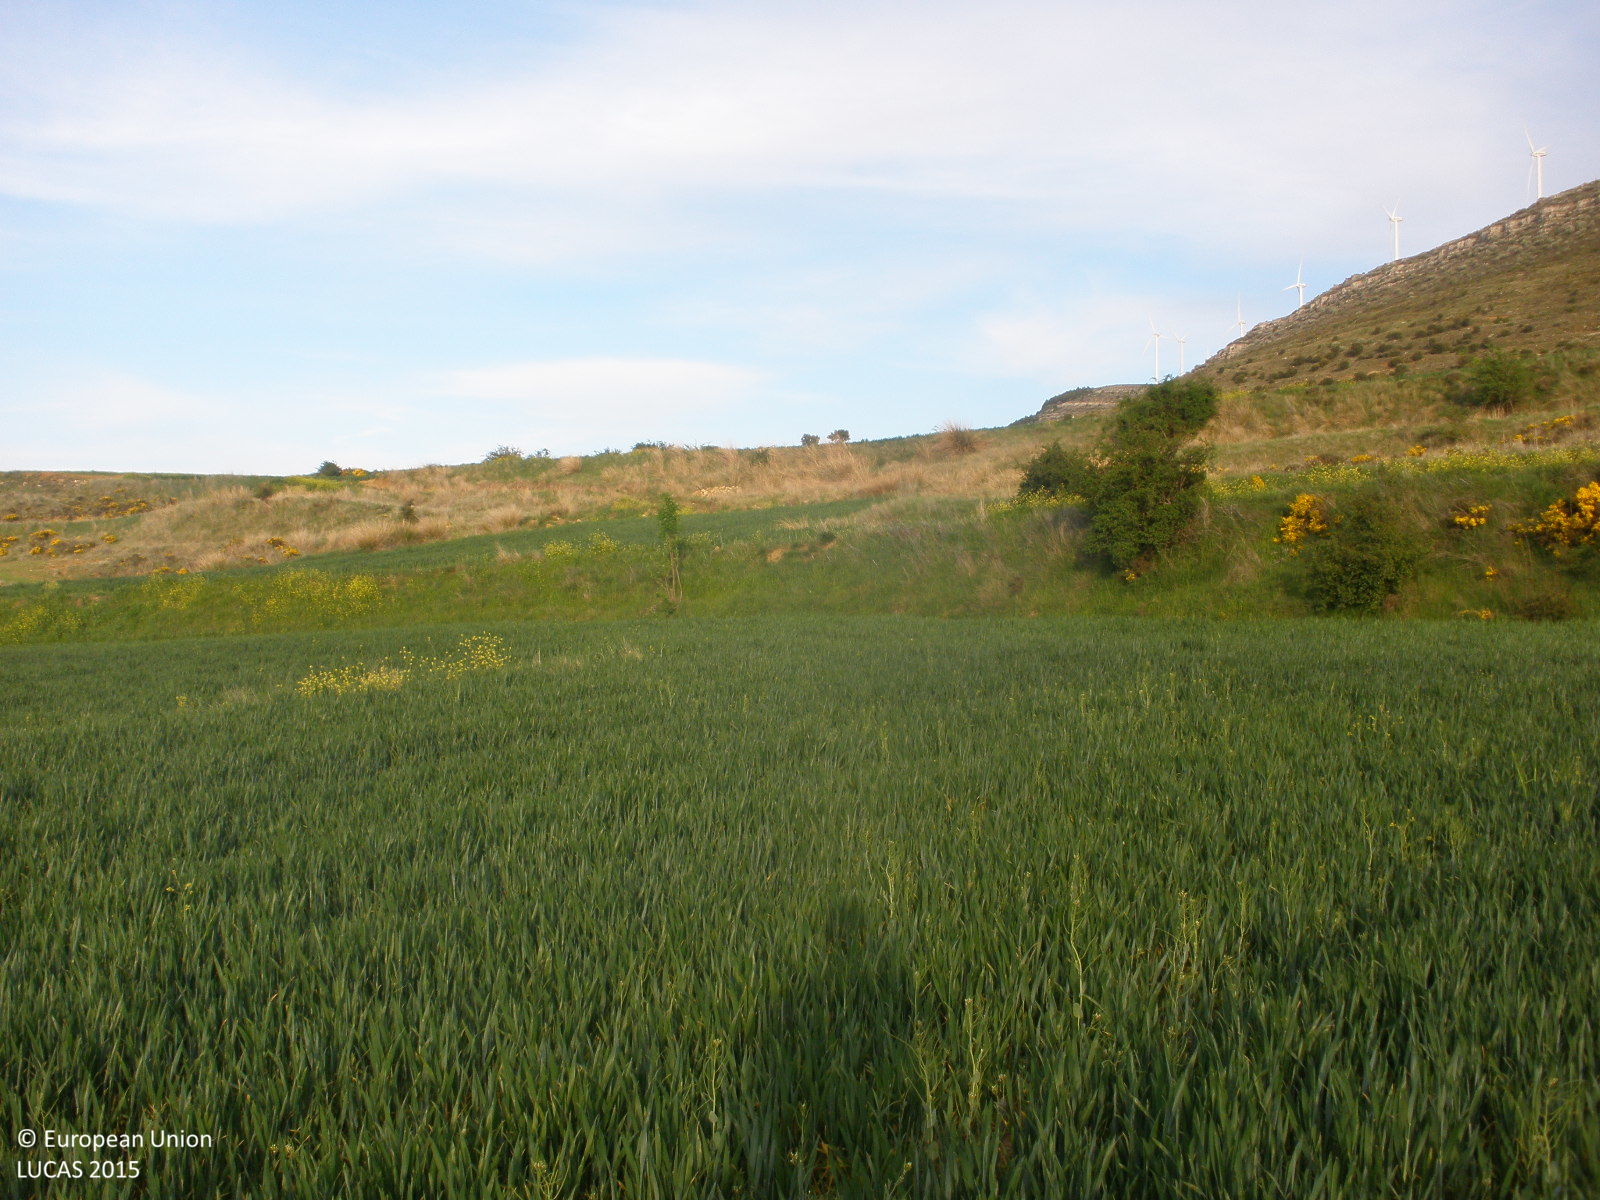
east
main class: Cropland
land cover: Durum wheat
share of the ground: > 75 %
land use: Agriculture (excluding fallow land and kitchen gardens)
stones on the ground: < 10 %
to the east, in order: Durum wheat; Grass margins; Durum wheat; Grass margins; Durum wheat; Grass margins; Grassland without tree/shrub cover; Tracks; Grassland without tree/shrub cover; Durum wheat; Grass margins; Barley; Grassland without tree/shrub cover; Durum wheat; Shrubland without tree cover; Durum wheat; Grassland without tree/shrub cover
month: May
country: ES
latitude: 40.8061
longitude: -0.9076
